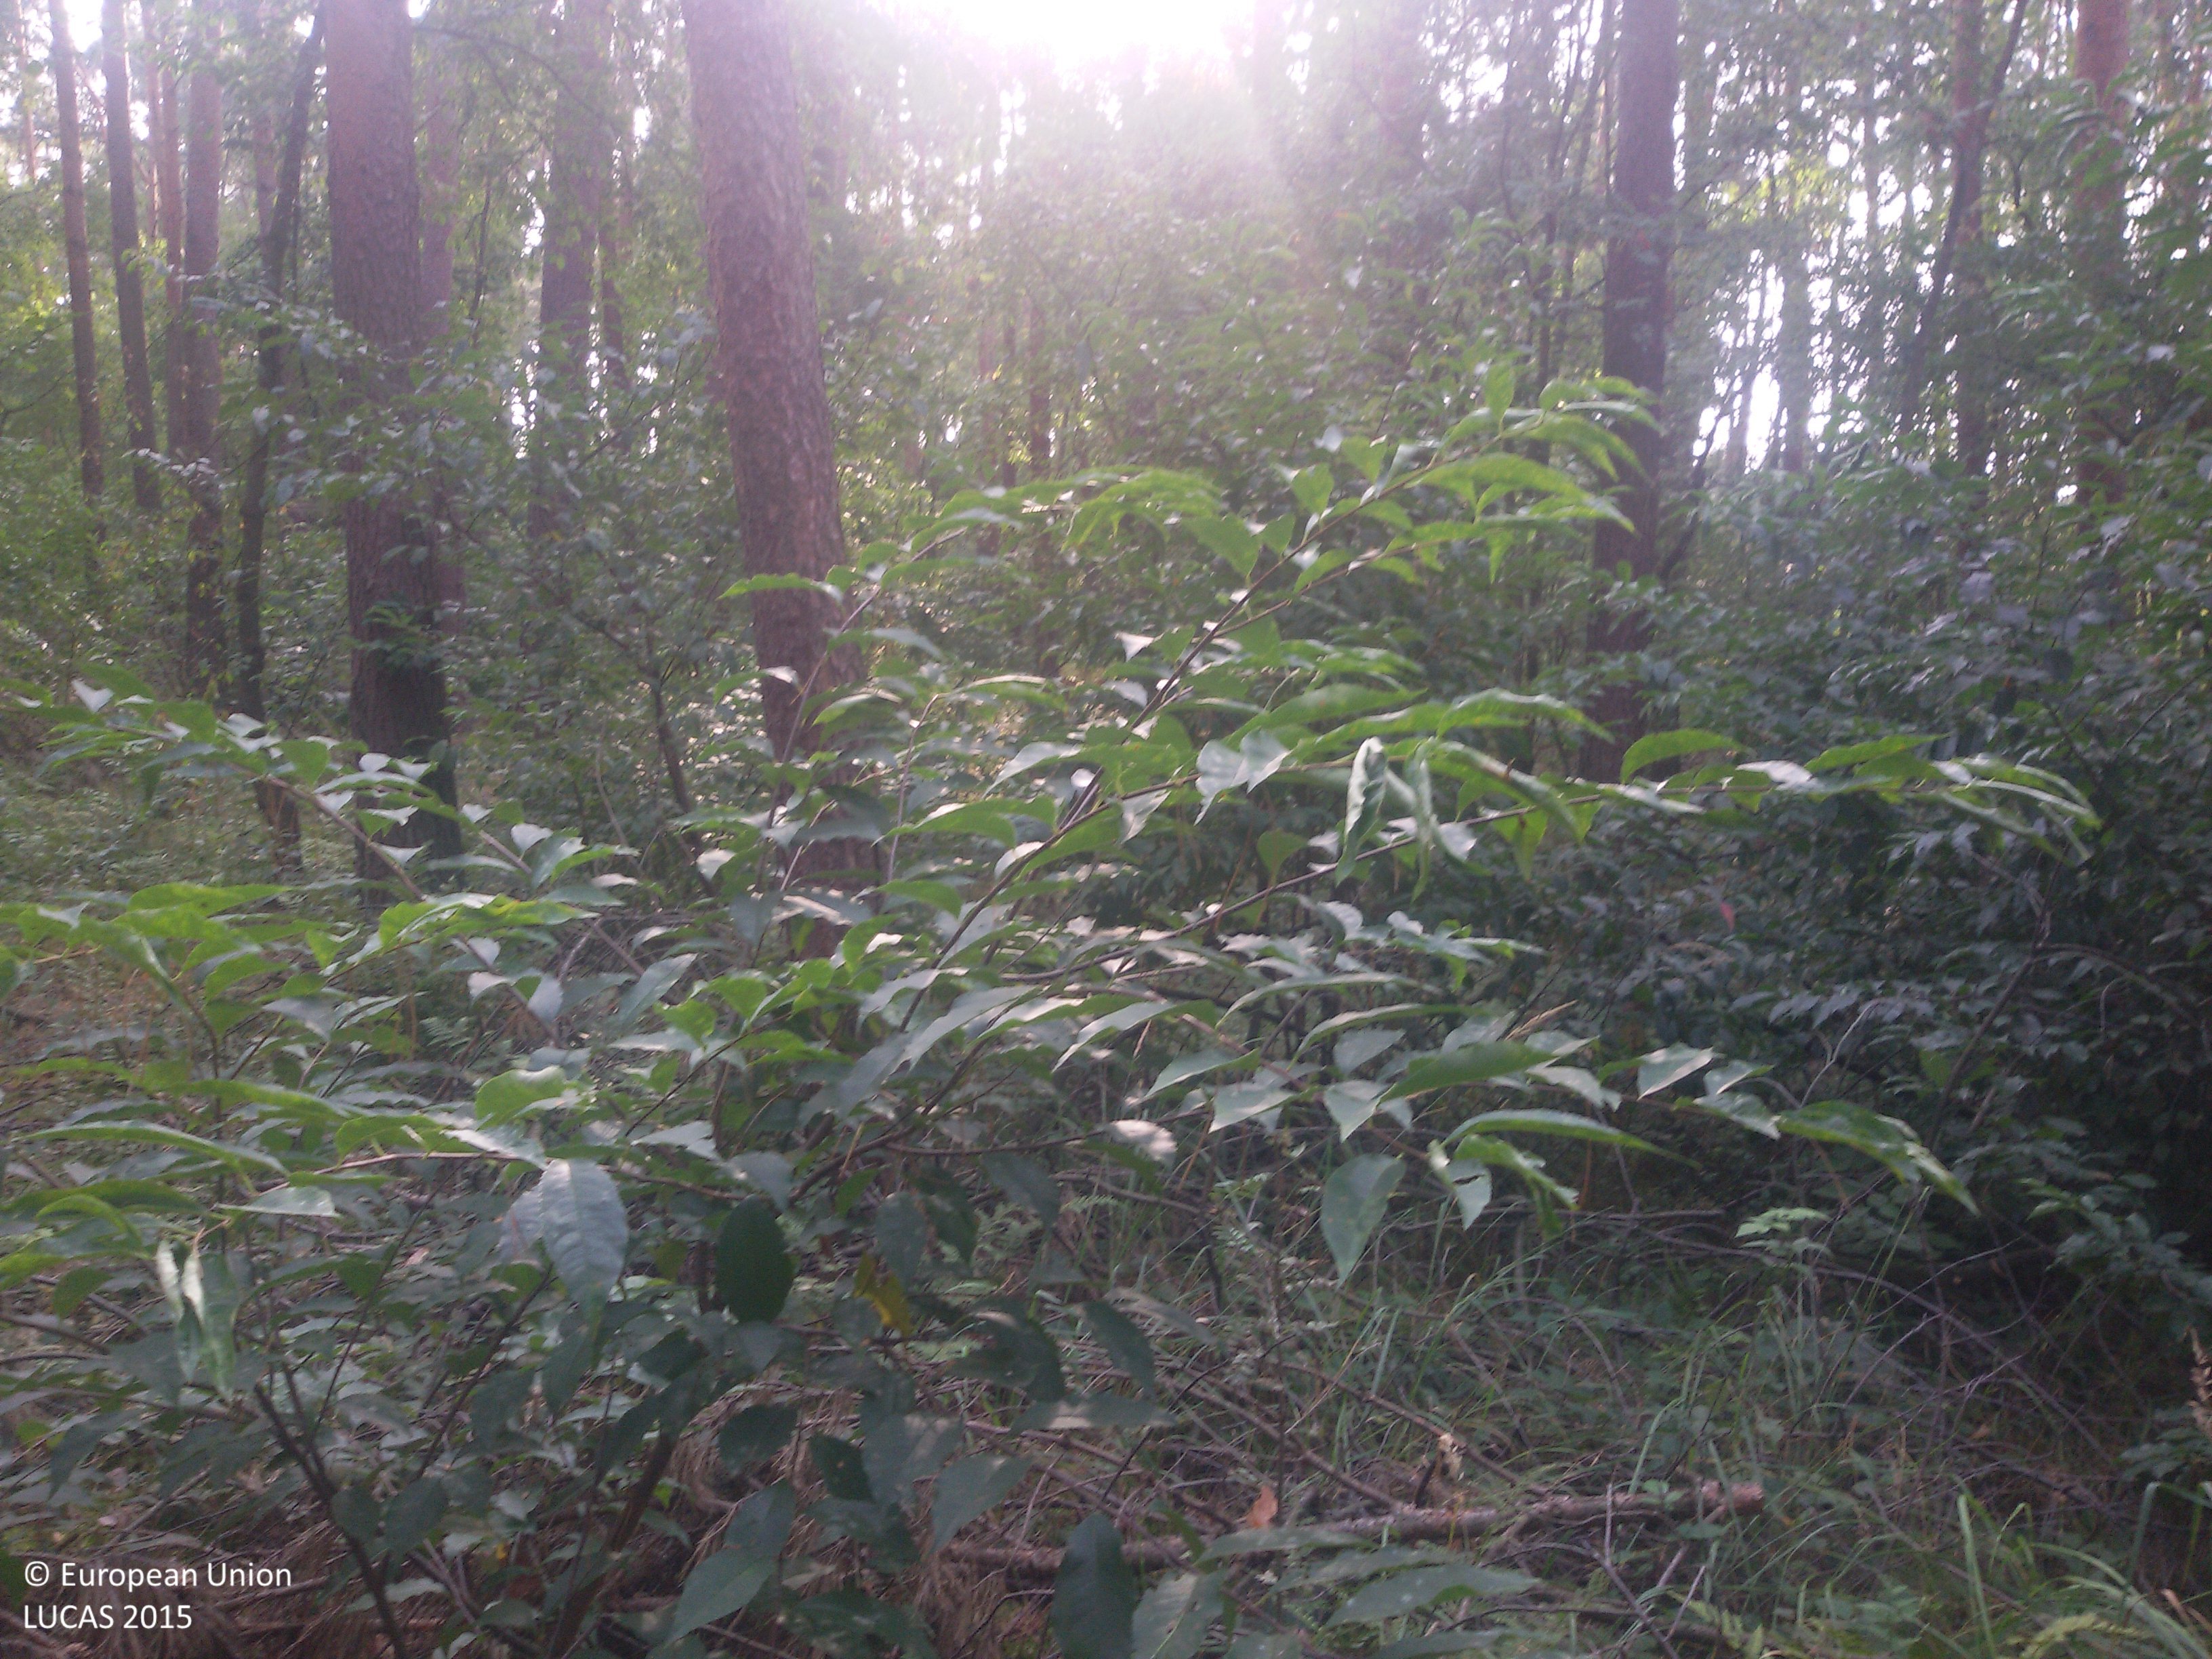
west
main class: Woodland
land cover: Pine dominated mixed woodland
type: hemiboreal forest and nemoral coniferous forest and mixed broadleaved-coniferous forest
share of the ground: > 75 %
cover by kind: coniferous forest trees 55 %, broadleaved forest trees 25 %, shrubs 10 %, herbaceous plants 5 %, unconsolidated bare surface 5 %
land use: Forestry
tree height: > 5 m
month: September
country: PL
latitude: 52.4502
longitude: 18.0054
